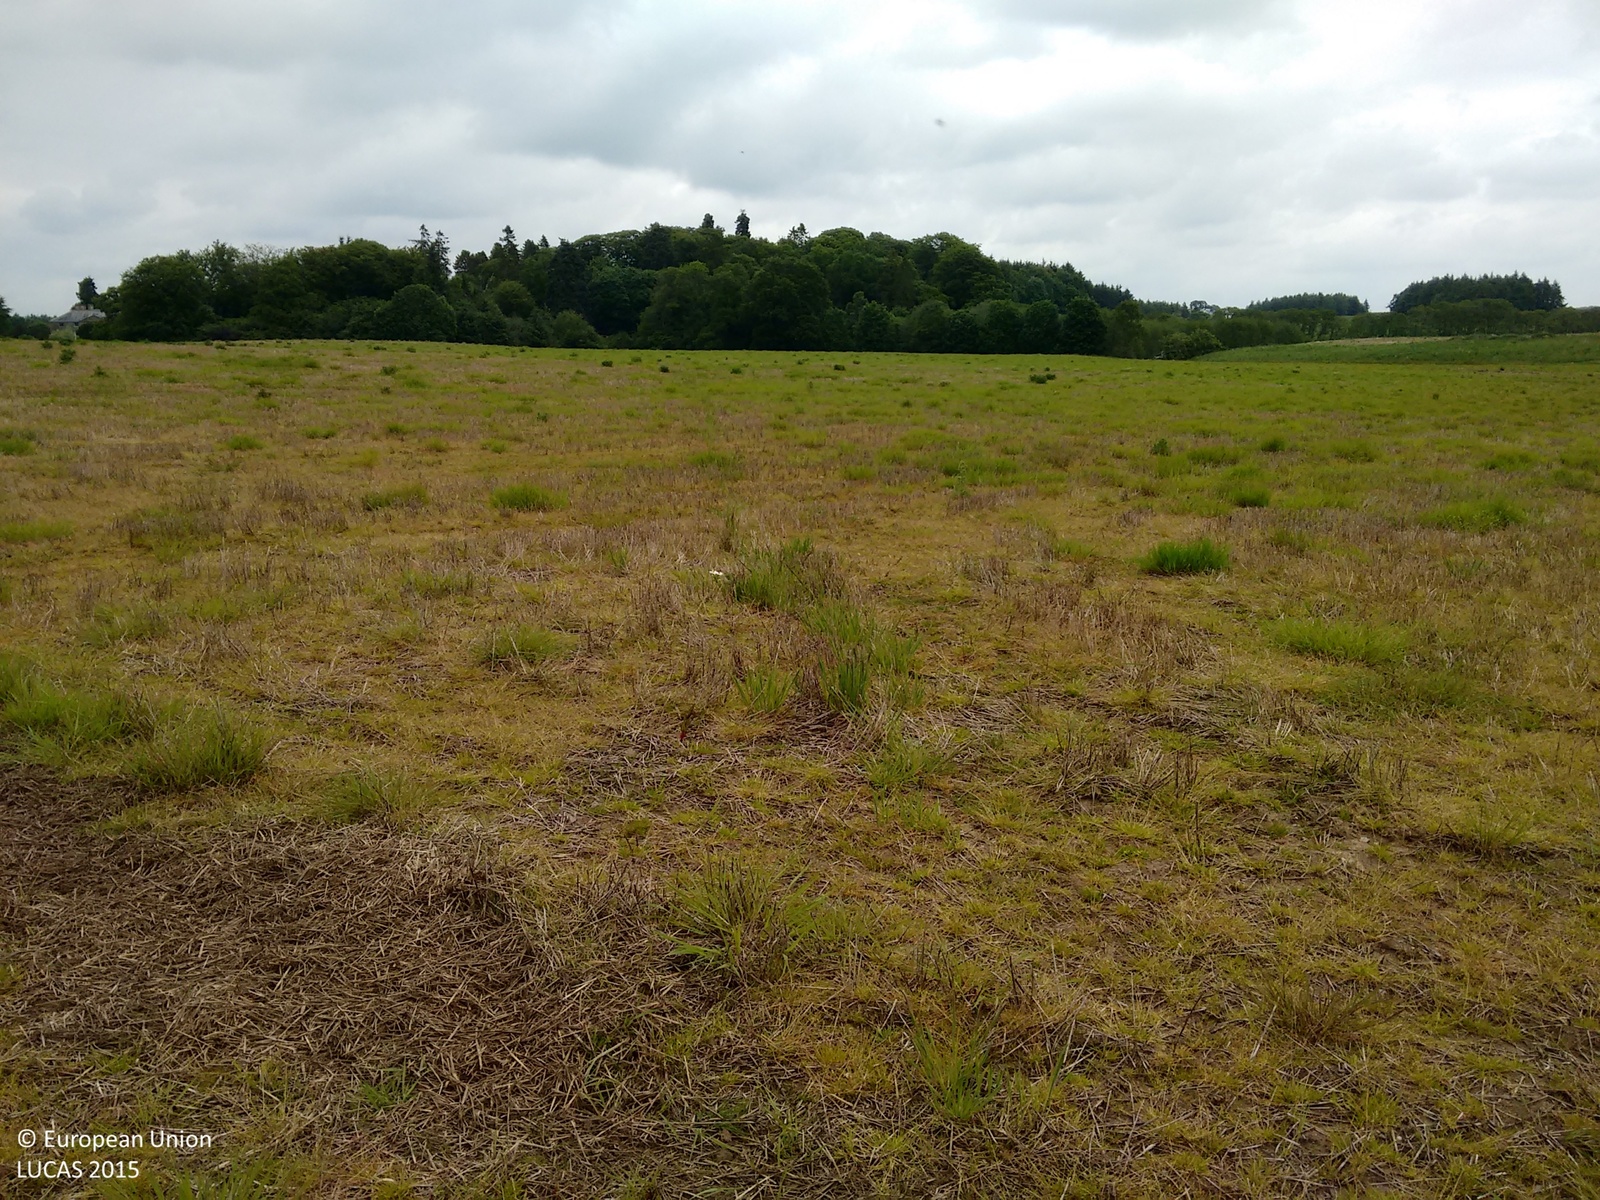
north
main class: Grassland
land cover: Spontaneously vegetated surfaces
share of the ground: > 75 %
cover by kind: herbaceous plants 85 %, unconsolidated bare surface 15 %
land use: Fallow land
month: June
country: GB
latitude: 56.4524
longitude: -3.3609
